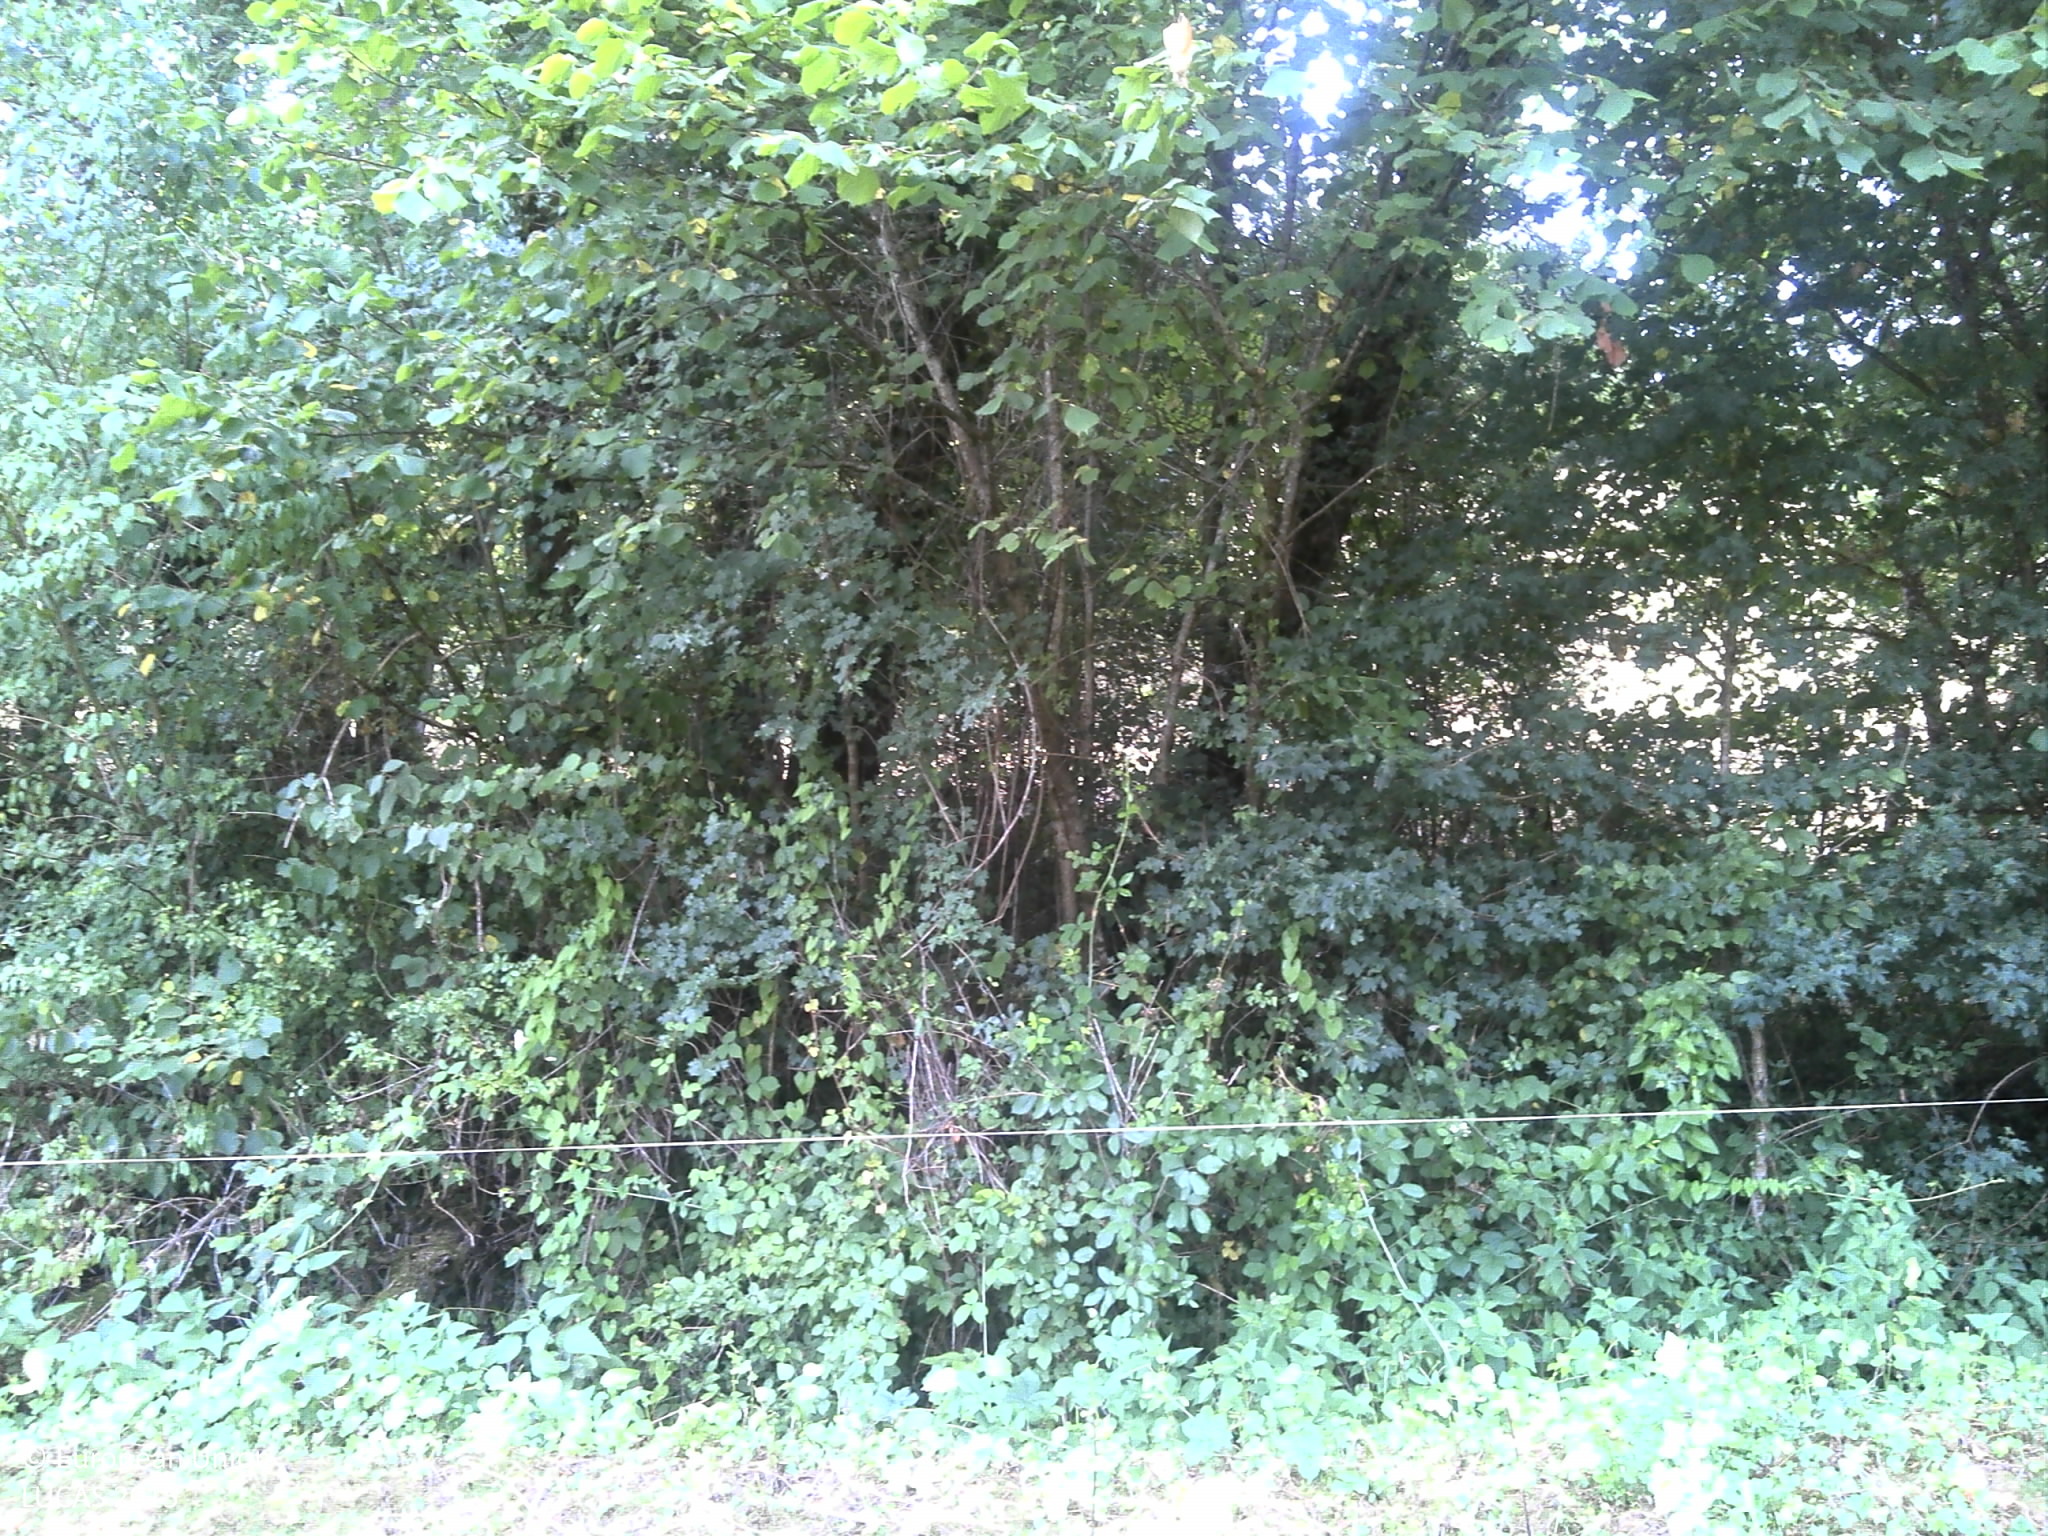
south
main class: Grassland
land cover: Spontaneously vegetated surfaces
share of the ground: > 75 %
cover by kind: herbaceous plants 100 %
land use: Agriculture (excluding fallow land and kitchen gardens)
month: July
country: FR
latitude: 45.0586
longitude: 1.5767
